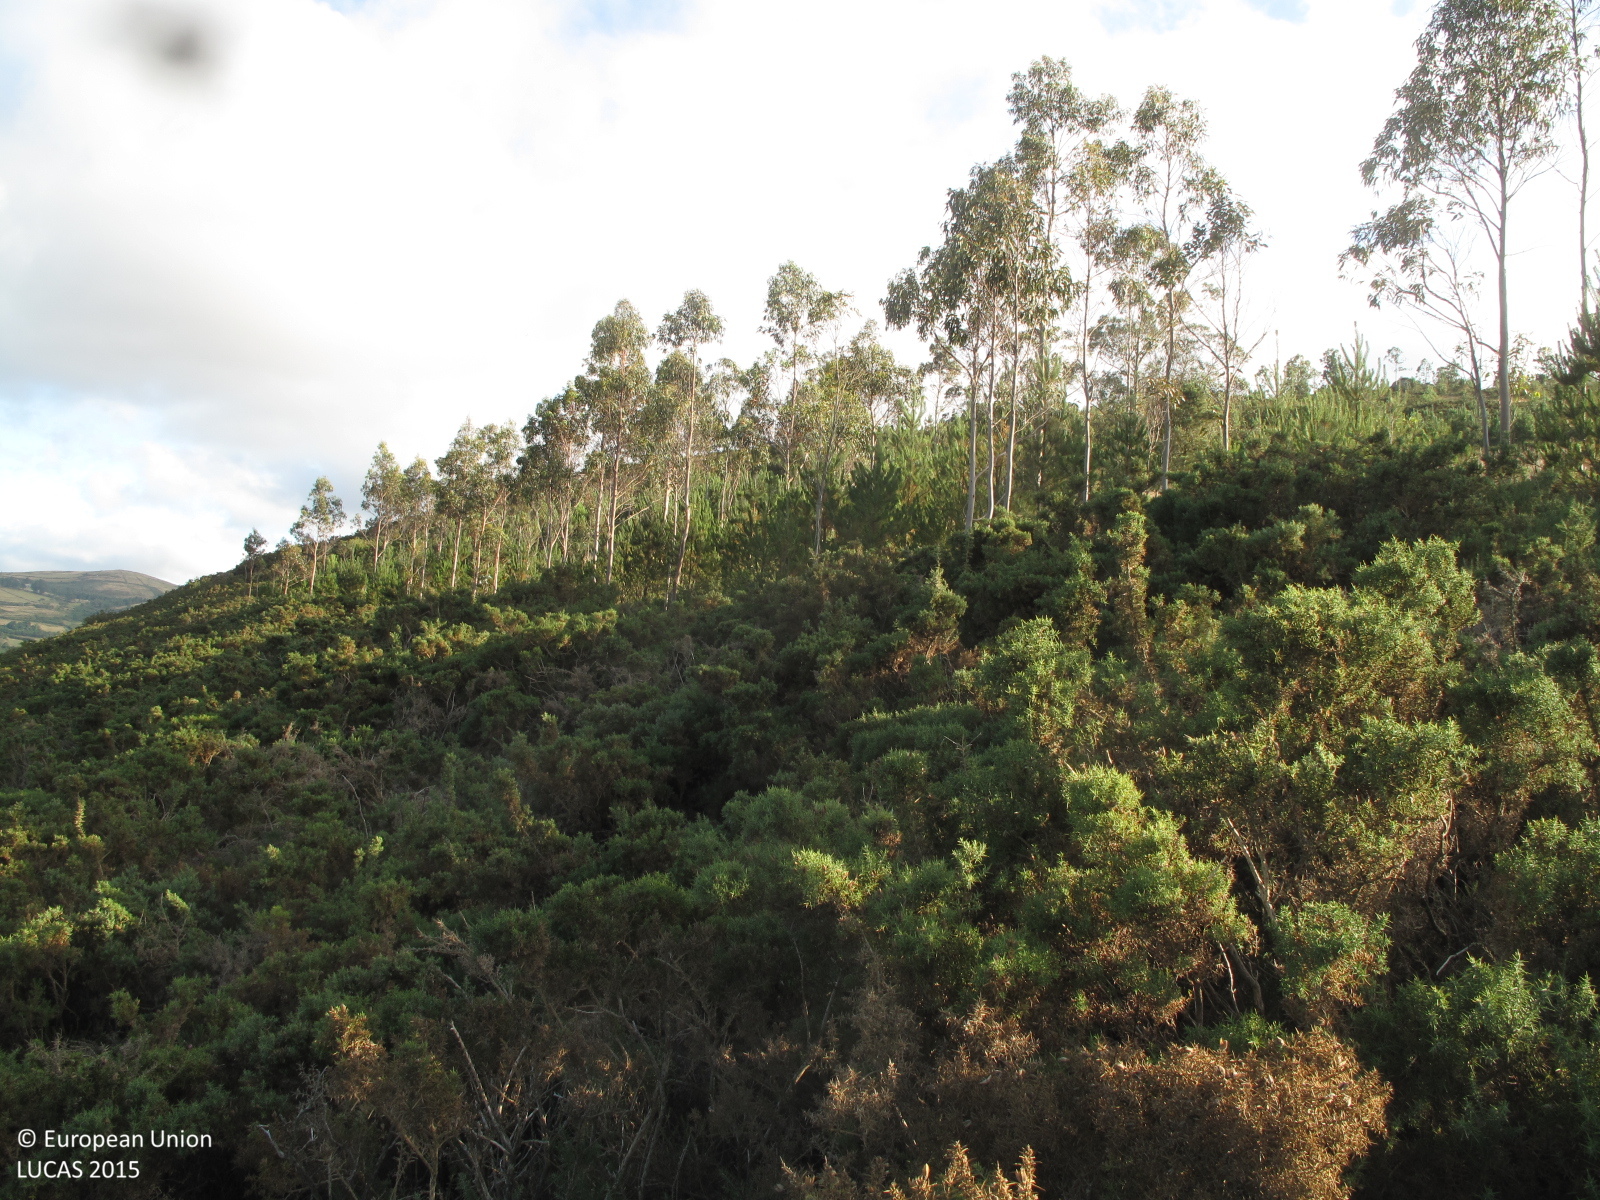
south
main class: Shrubland
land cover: Shrubland without tree cover
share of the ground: > 75 %
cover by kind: shrubs 90 %, herbaceous plants 10 %
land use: Semi-natural and natural areas not in use
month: July
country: ES
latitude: 42.9474
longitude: -9.0837
